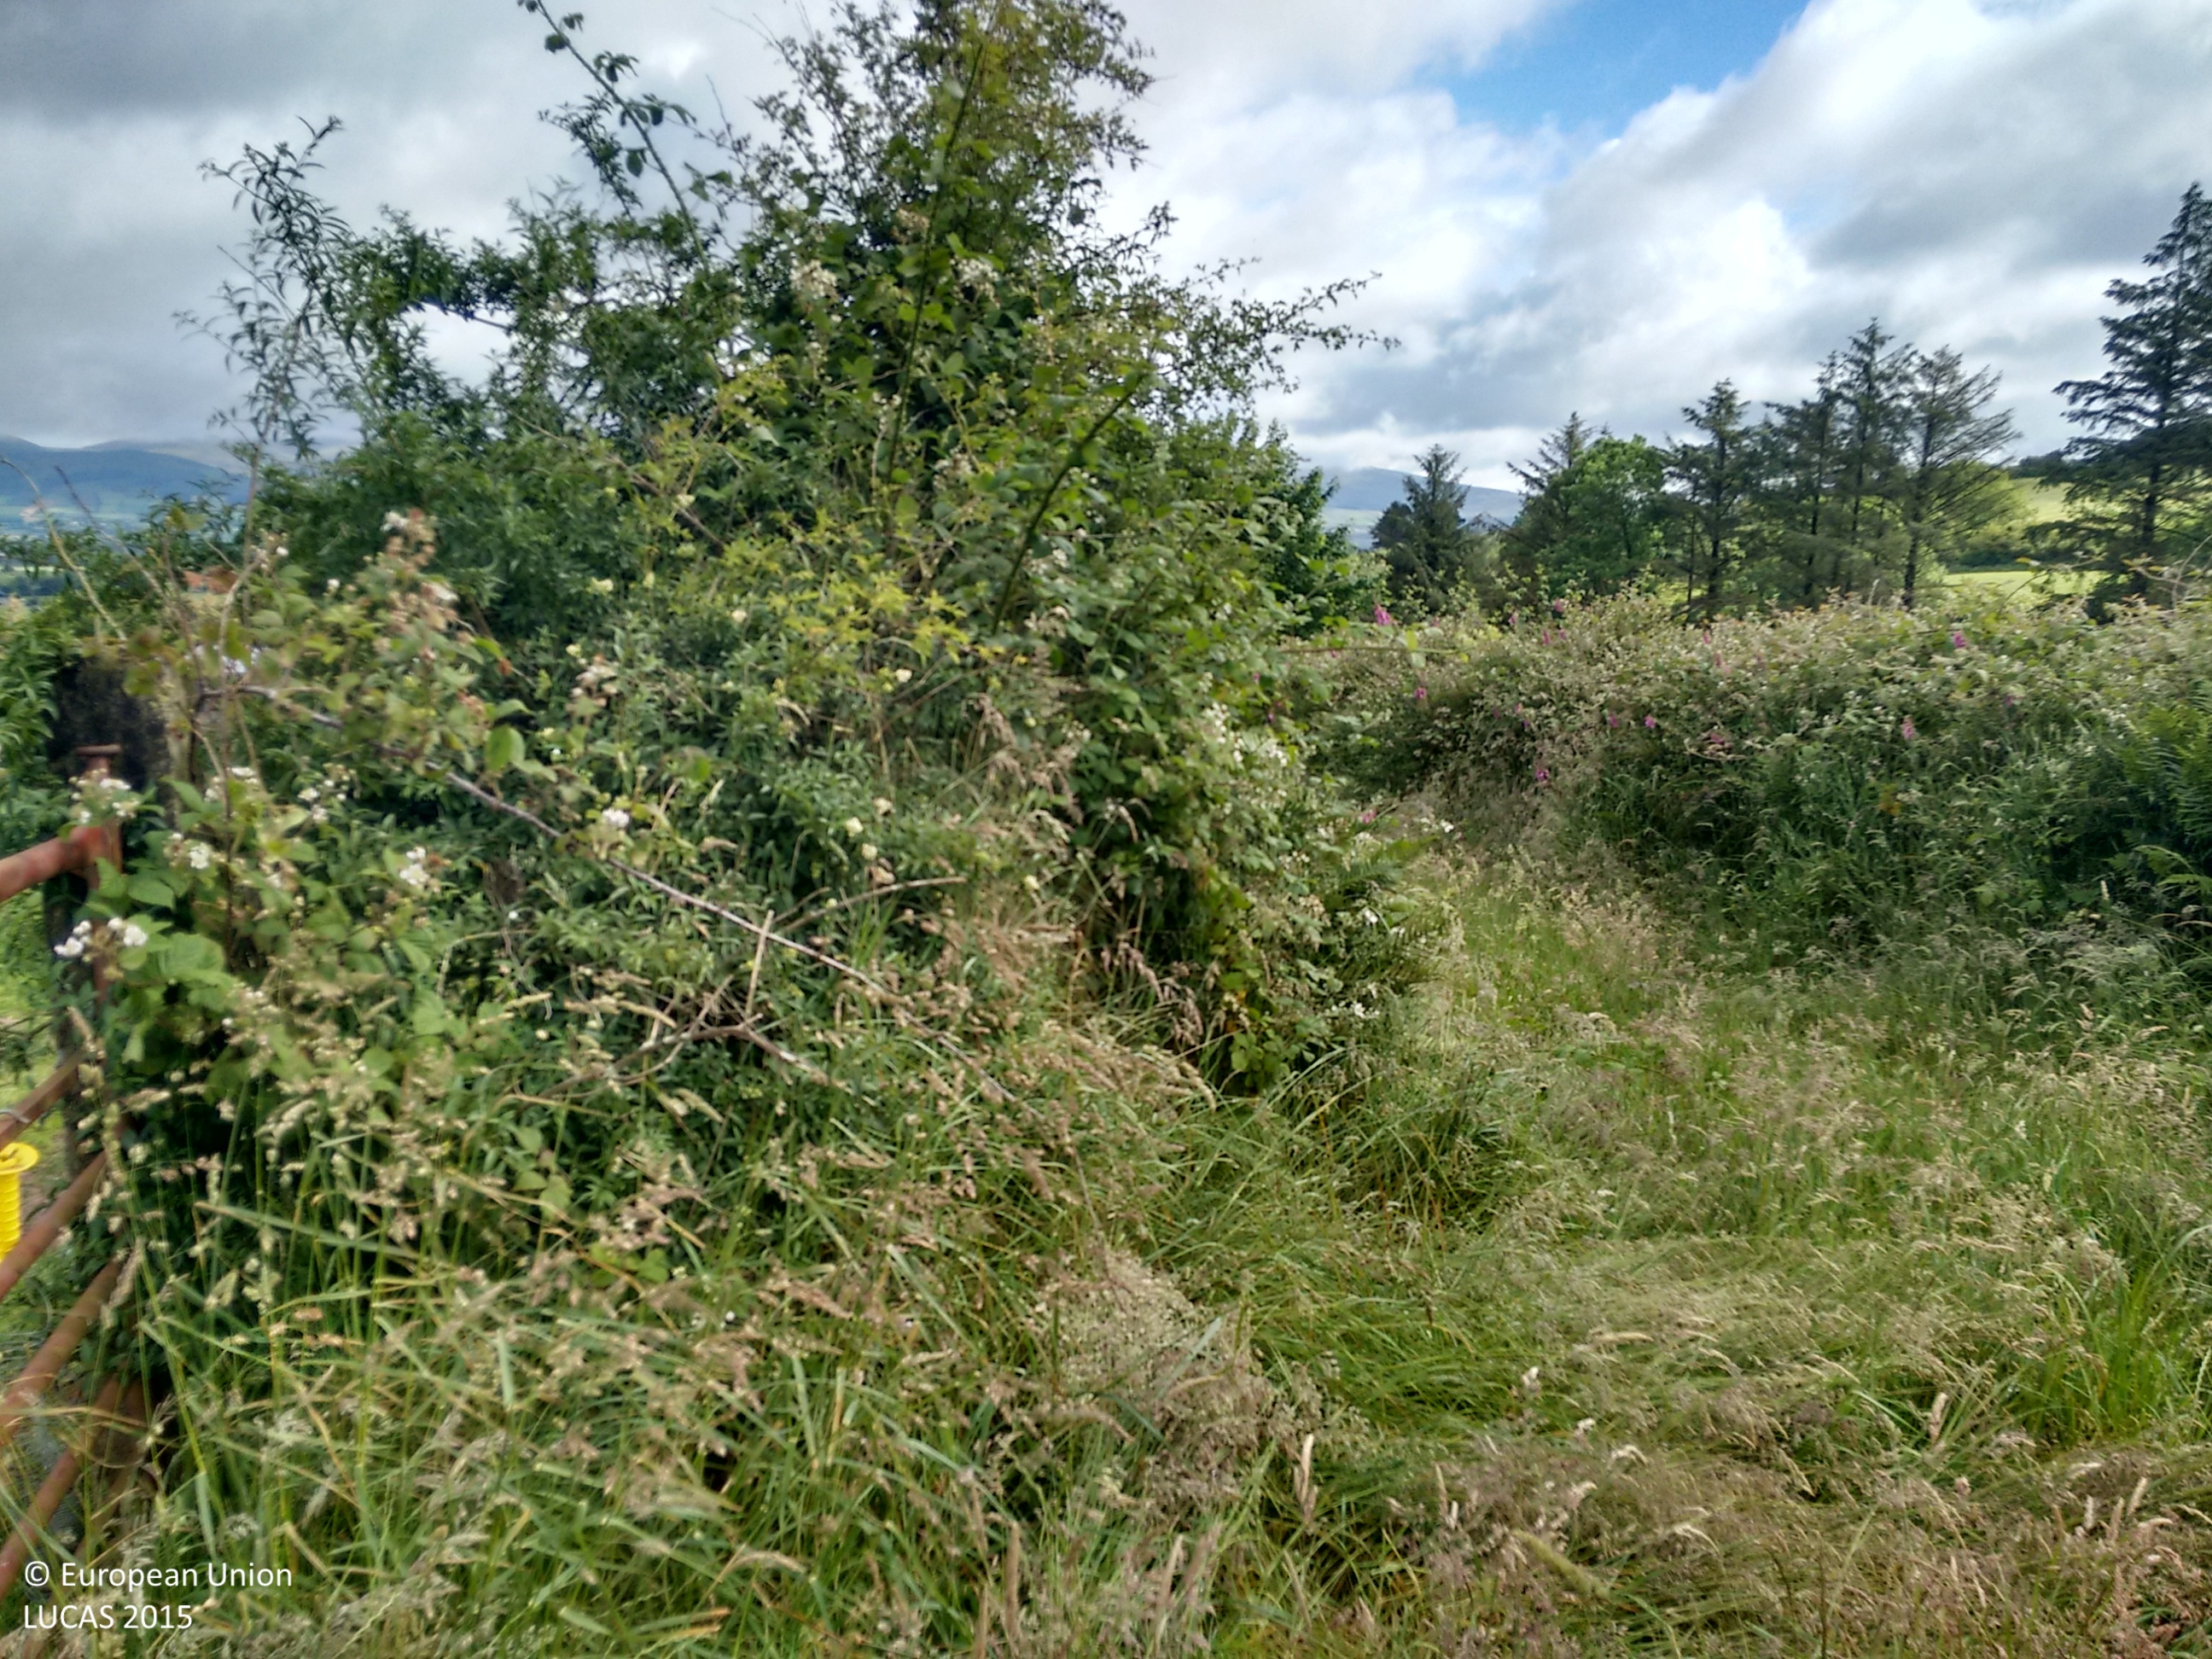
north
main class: Grassland
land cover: Grassland without tree/shrub cover
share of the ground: > 75 %
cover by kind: herbaceous plants 100 %
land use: Agriculture (excluding fallow land and kitchen gardens)
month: July
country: IE
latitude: 52.2475
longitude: -8.1836
